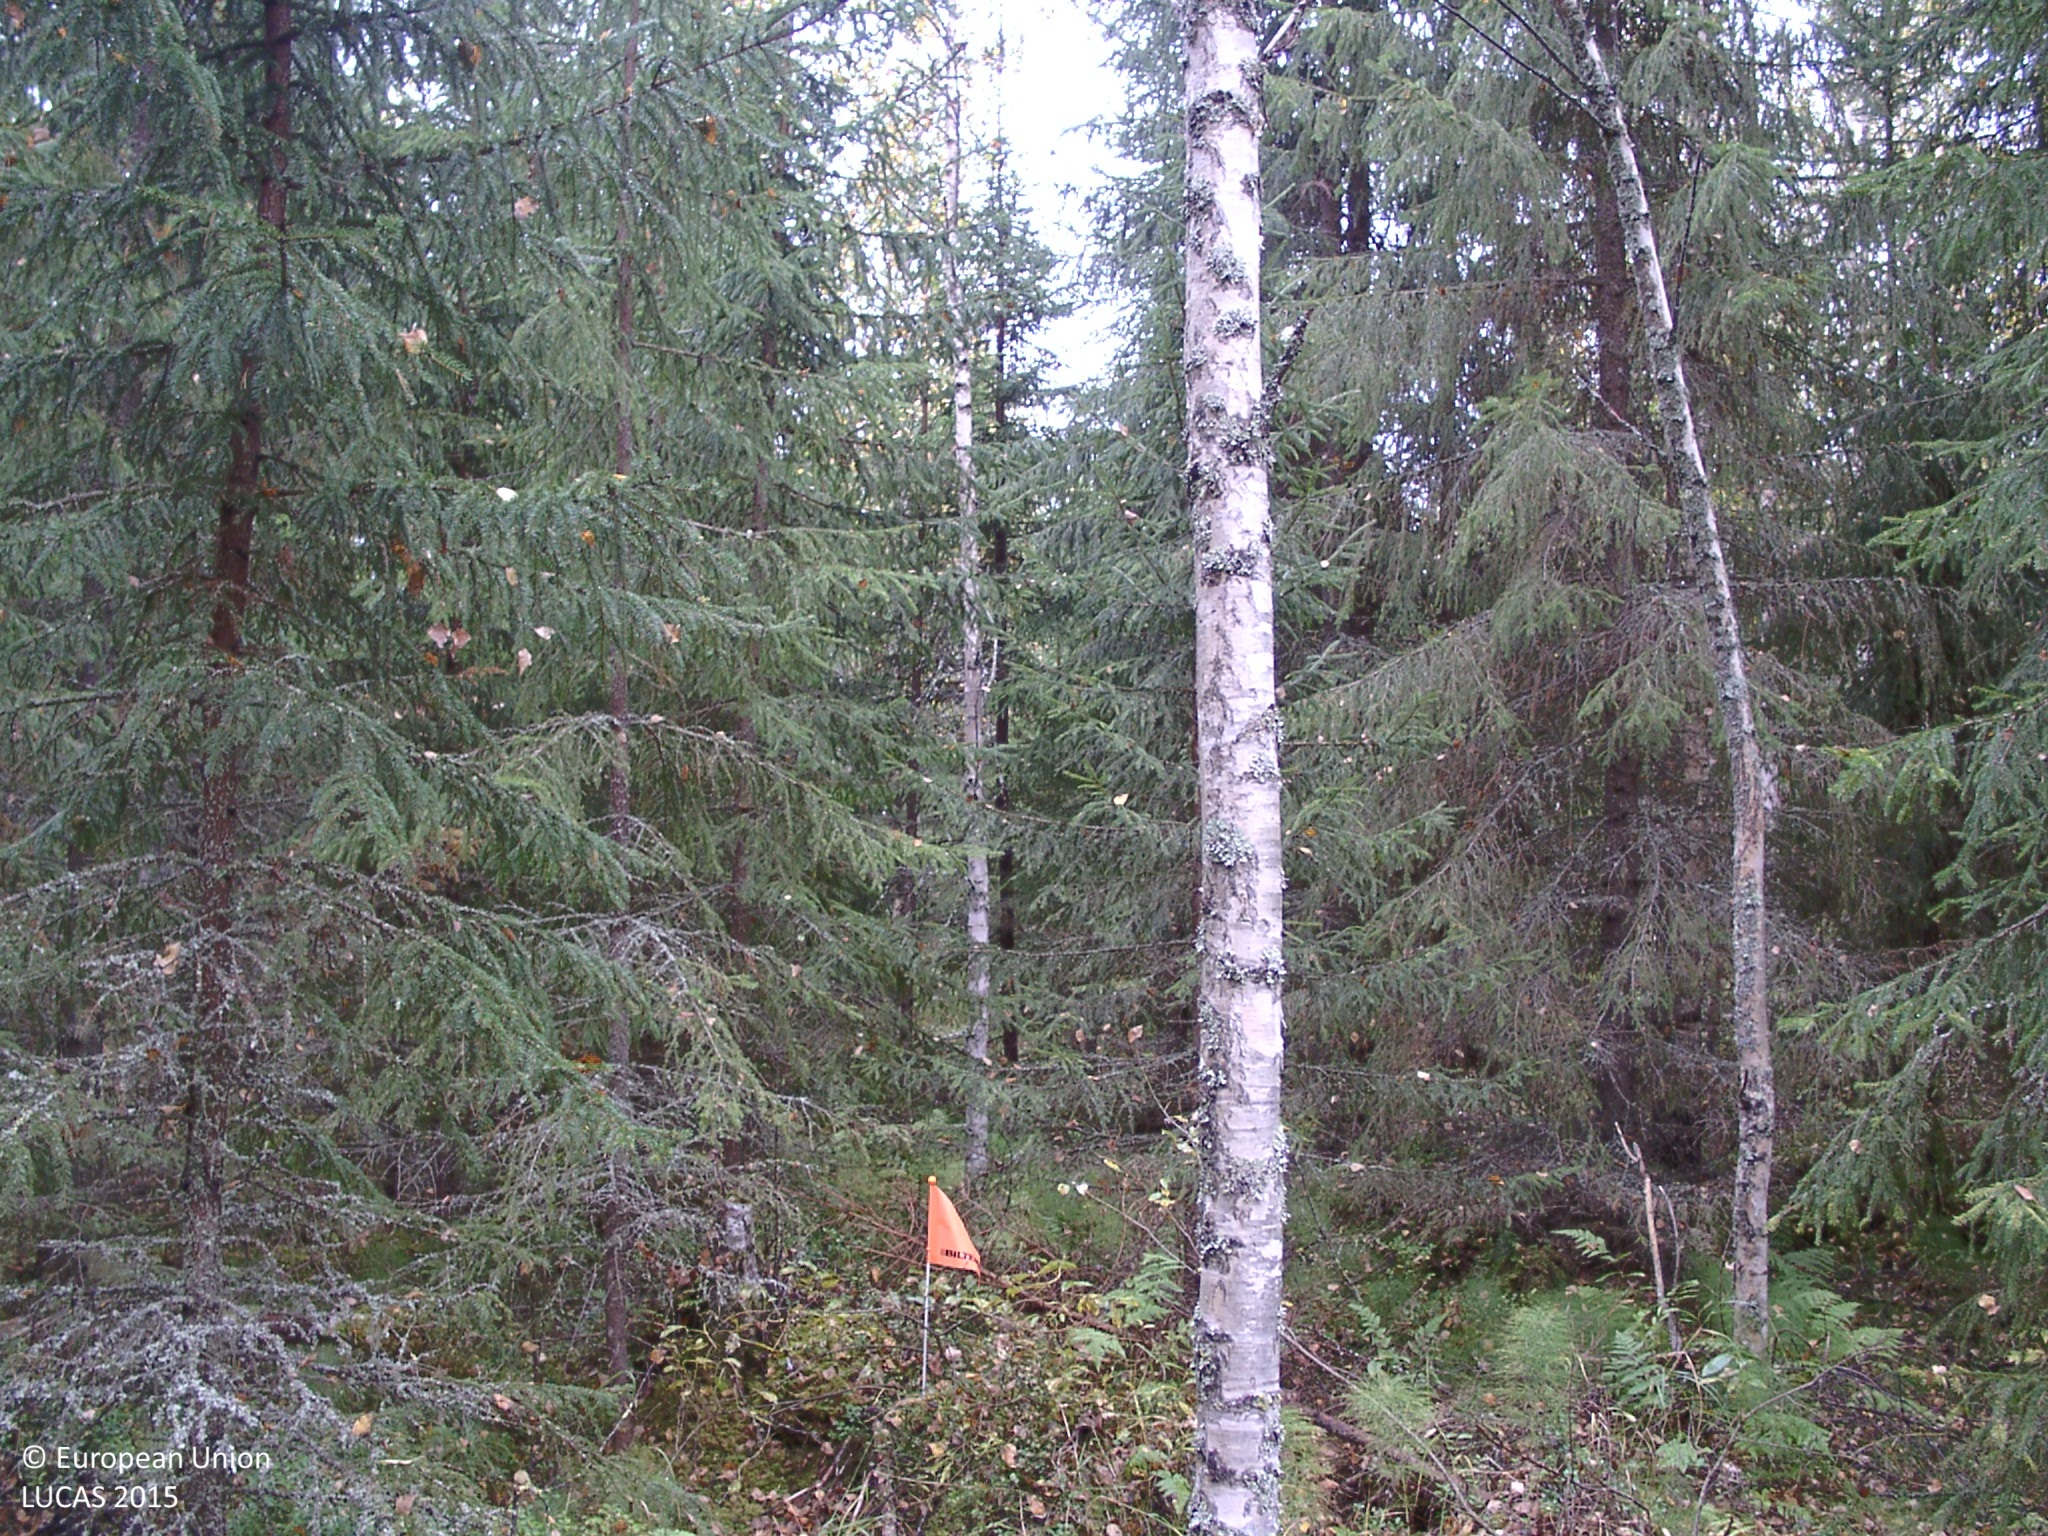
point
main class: Woodland
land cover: Other mixed woodland
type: boreal forest
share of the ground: 50 - 75 %
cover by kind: coniferous forest trees 45 %, broadleaved forest trees 25 %, shrubs 10 %, herbaceous plants 10 %, lichens and mosses 10 %
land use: Forestry
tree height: > 5 m
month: September
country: FI
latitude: 62.6831
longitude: 25.7217
